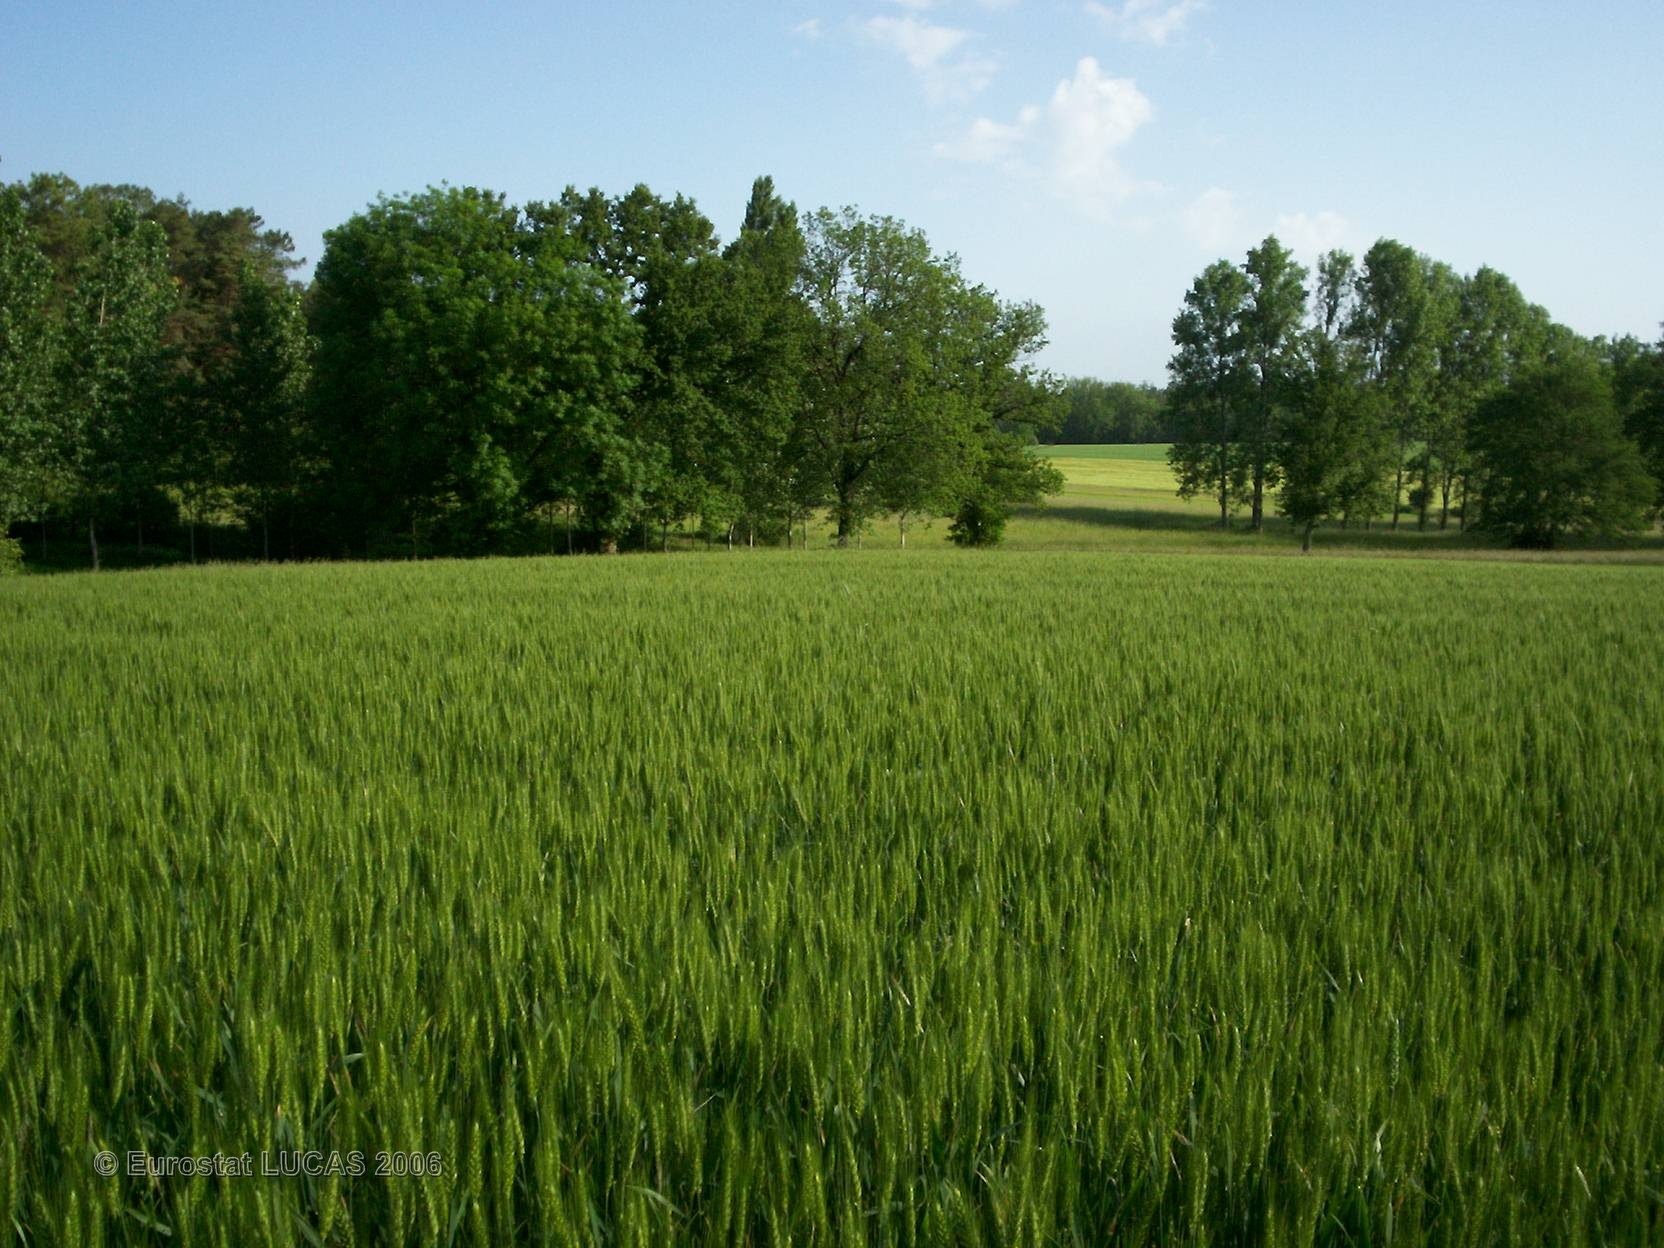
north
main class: Cropland
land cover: Triticale
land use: Agriculture (excluding fallow land and kitchen gardens)
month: May
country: FR
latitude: 45.3233
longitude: 0.6374
